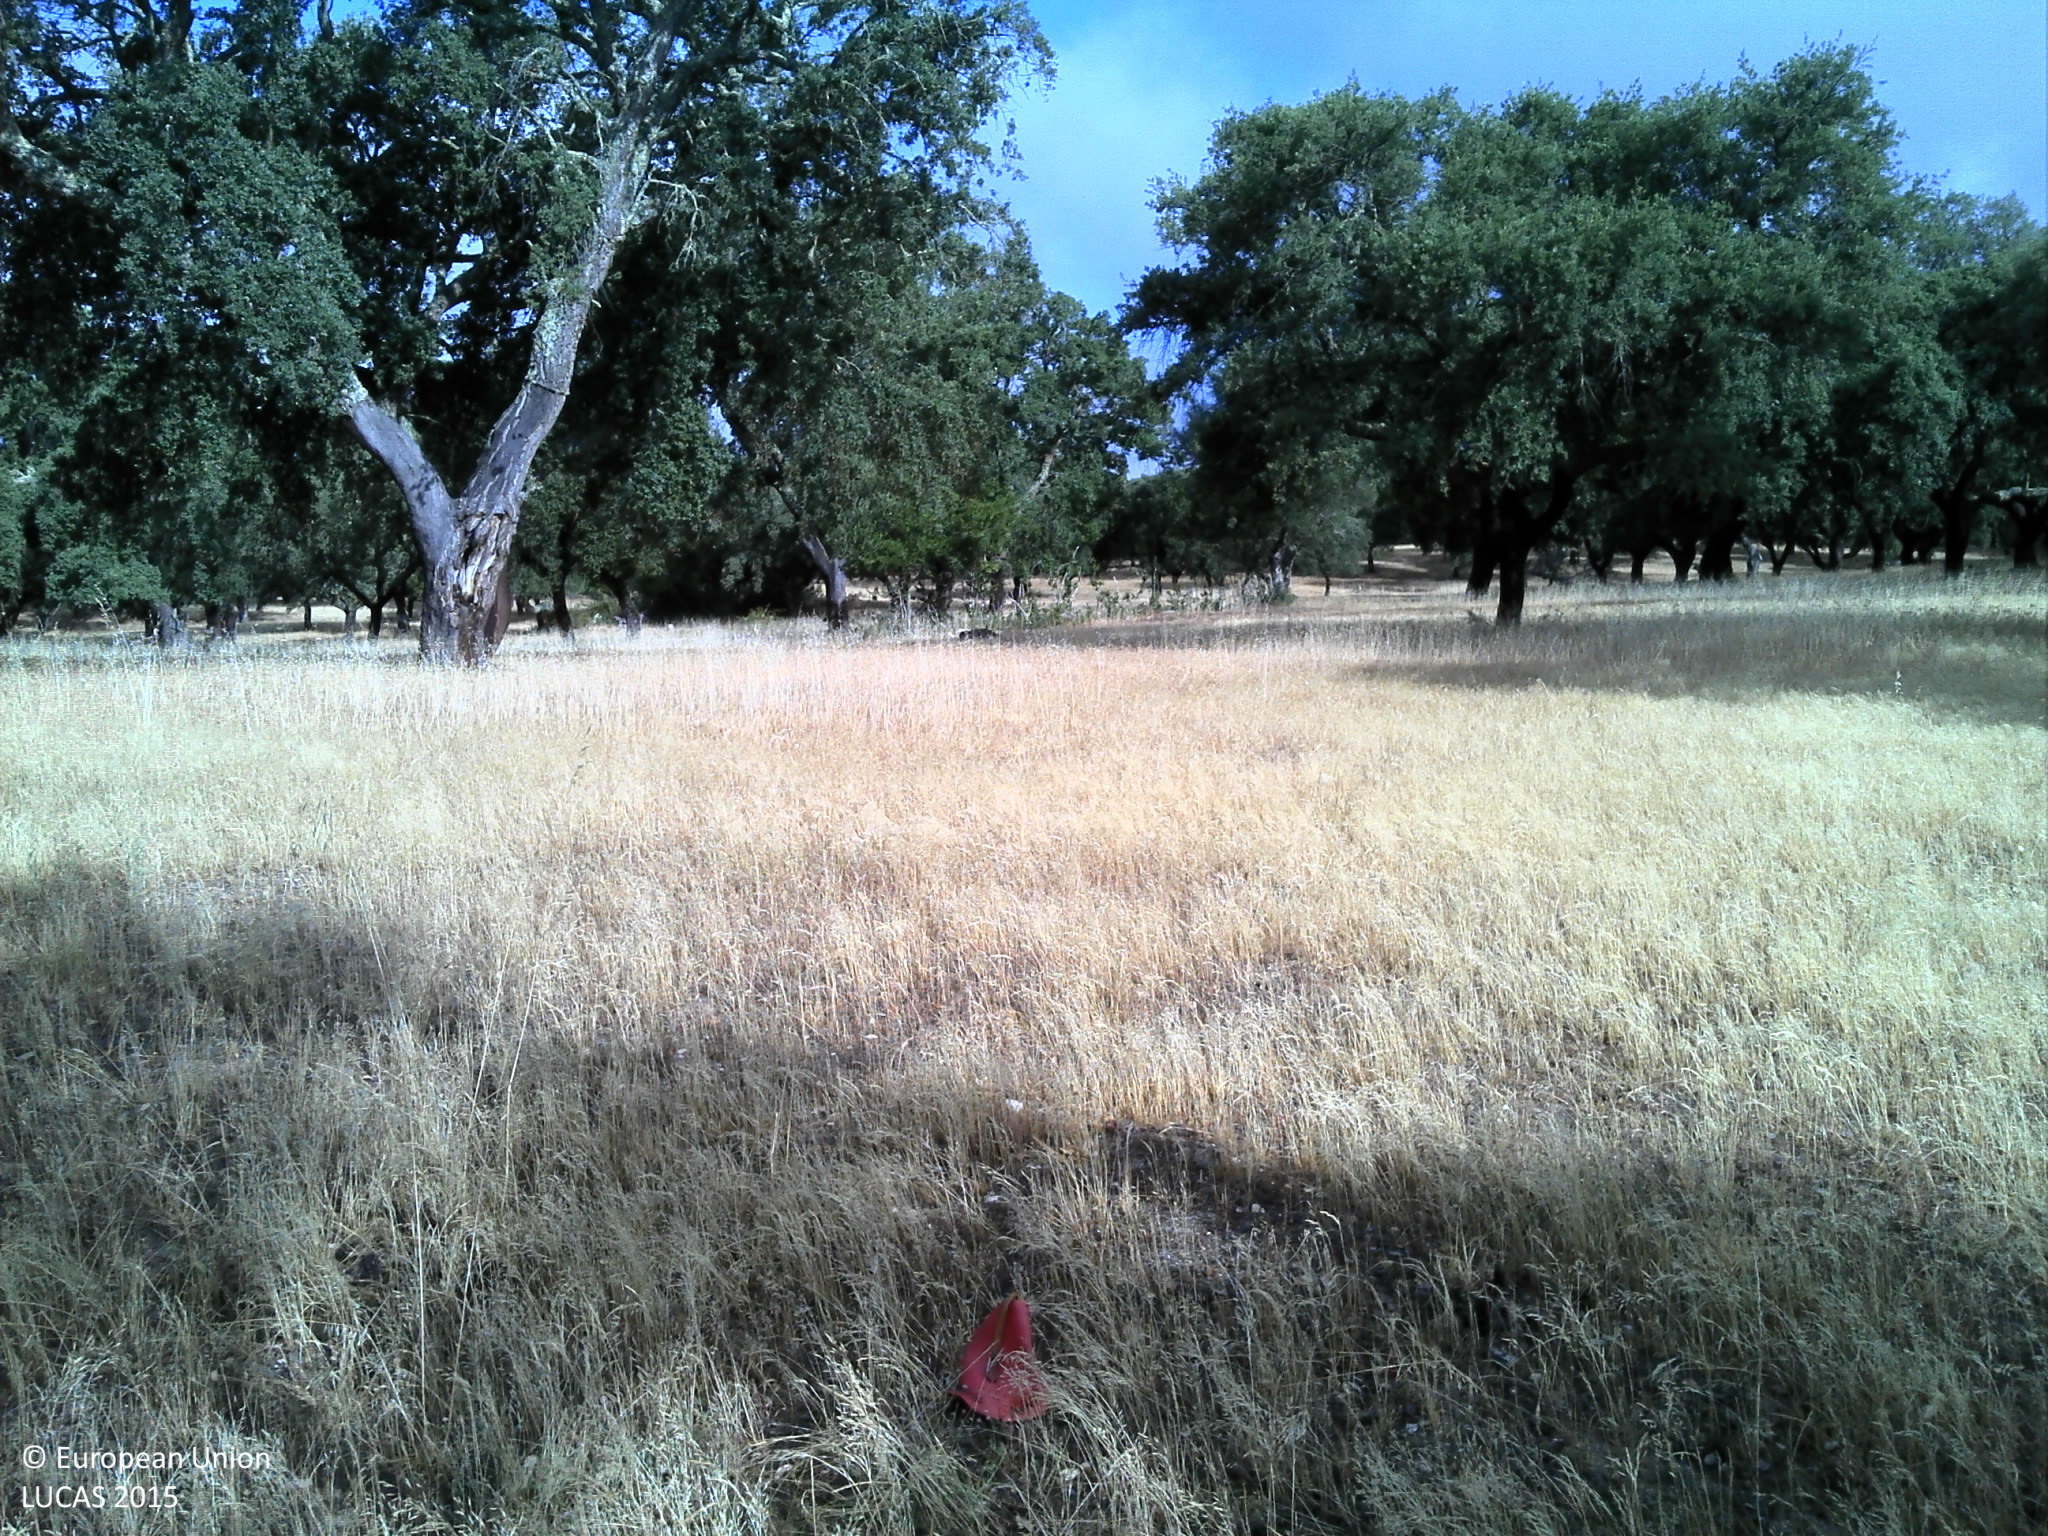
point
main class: Woodland
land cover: Broadleaved woodland
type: broadleaved evergreen forest
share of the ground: 10 - 25 %
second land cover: Spontaneously vegetated surfaces
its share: 25 - 50 %
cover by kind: herbaceous plants 50 %, unconsolidated bare surface 40 %, broadleaved forest trees 10 %
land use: Forestry
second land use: Agriculture (excluding fallow land and kitchen gardens)
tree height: > 5 m
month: June
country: PT
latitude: 38.5811
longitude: -8.0307
